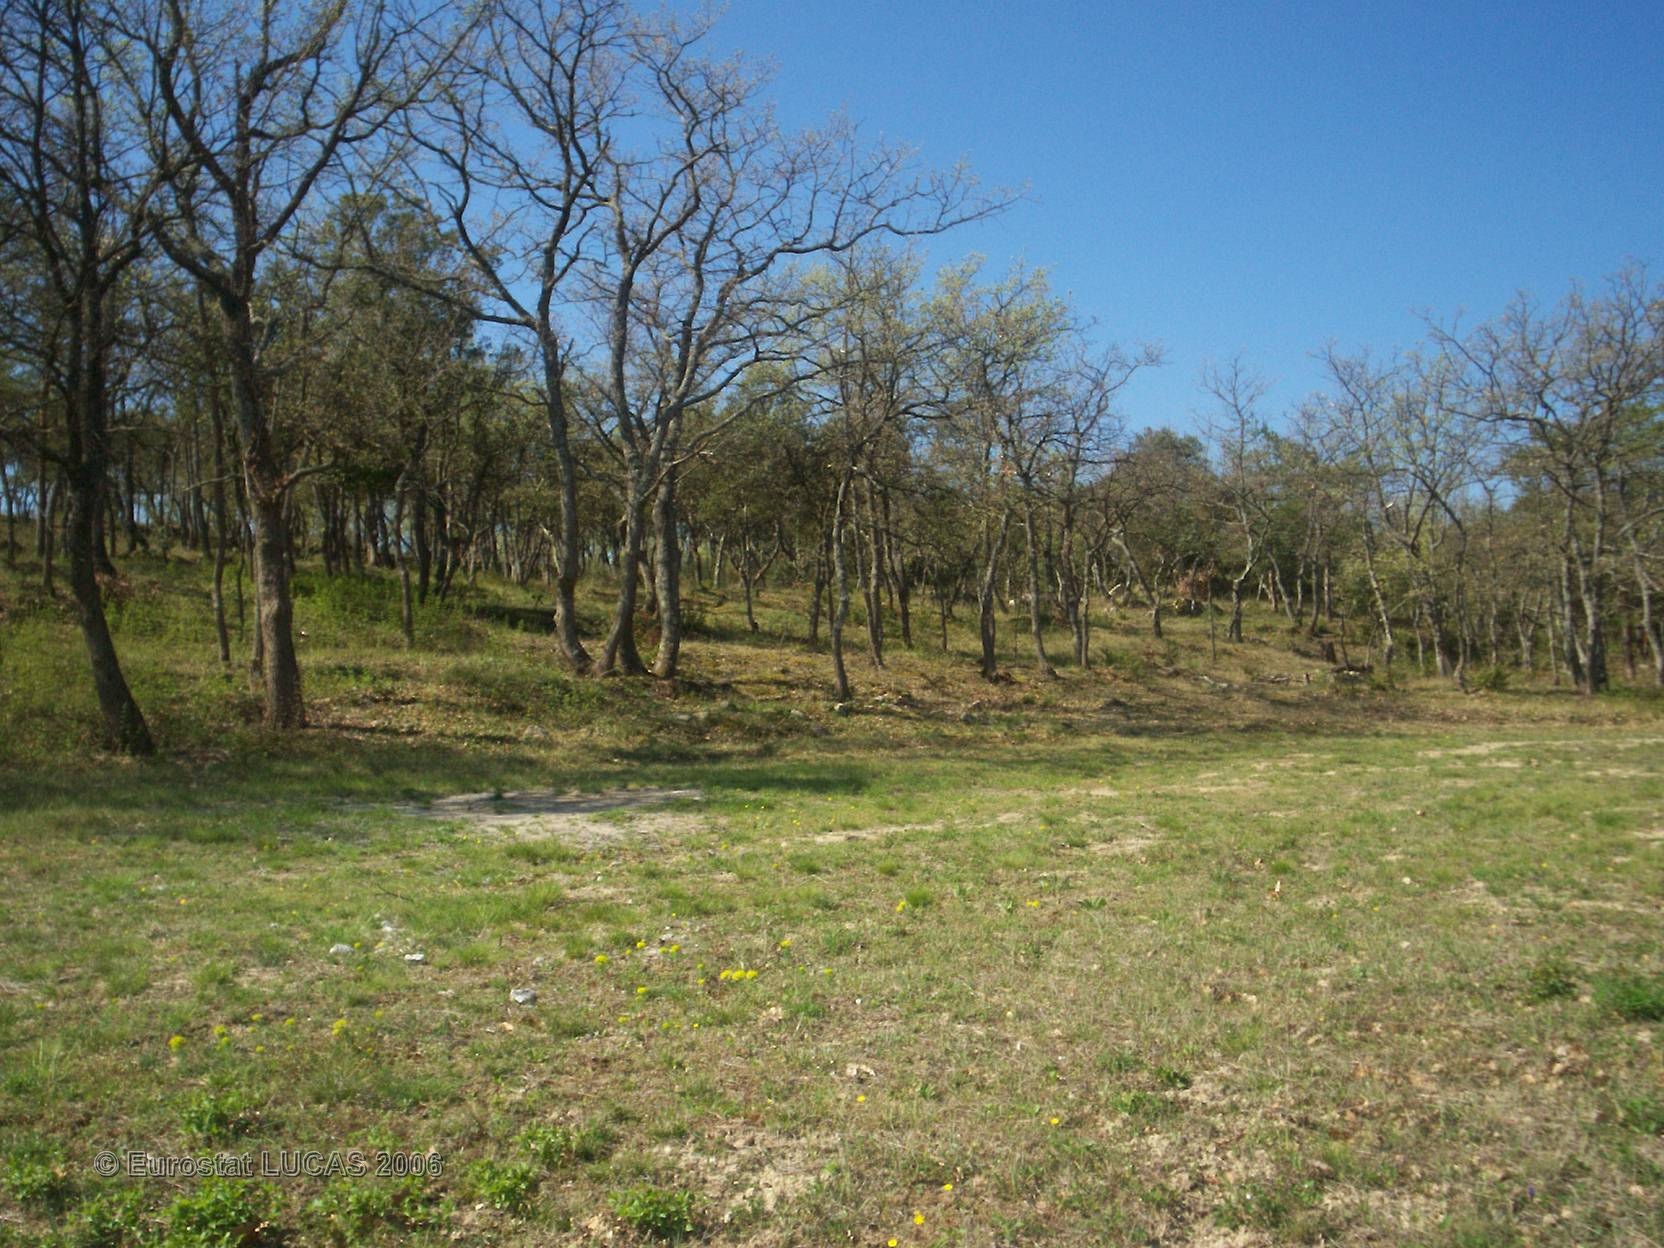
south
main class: Grassland
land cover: Grassland without tree/shrub cover
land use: Agriculture (excluding fallow land and kitchen gardens)
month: April
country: FR
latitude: 43.8452
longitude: 5.2697
